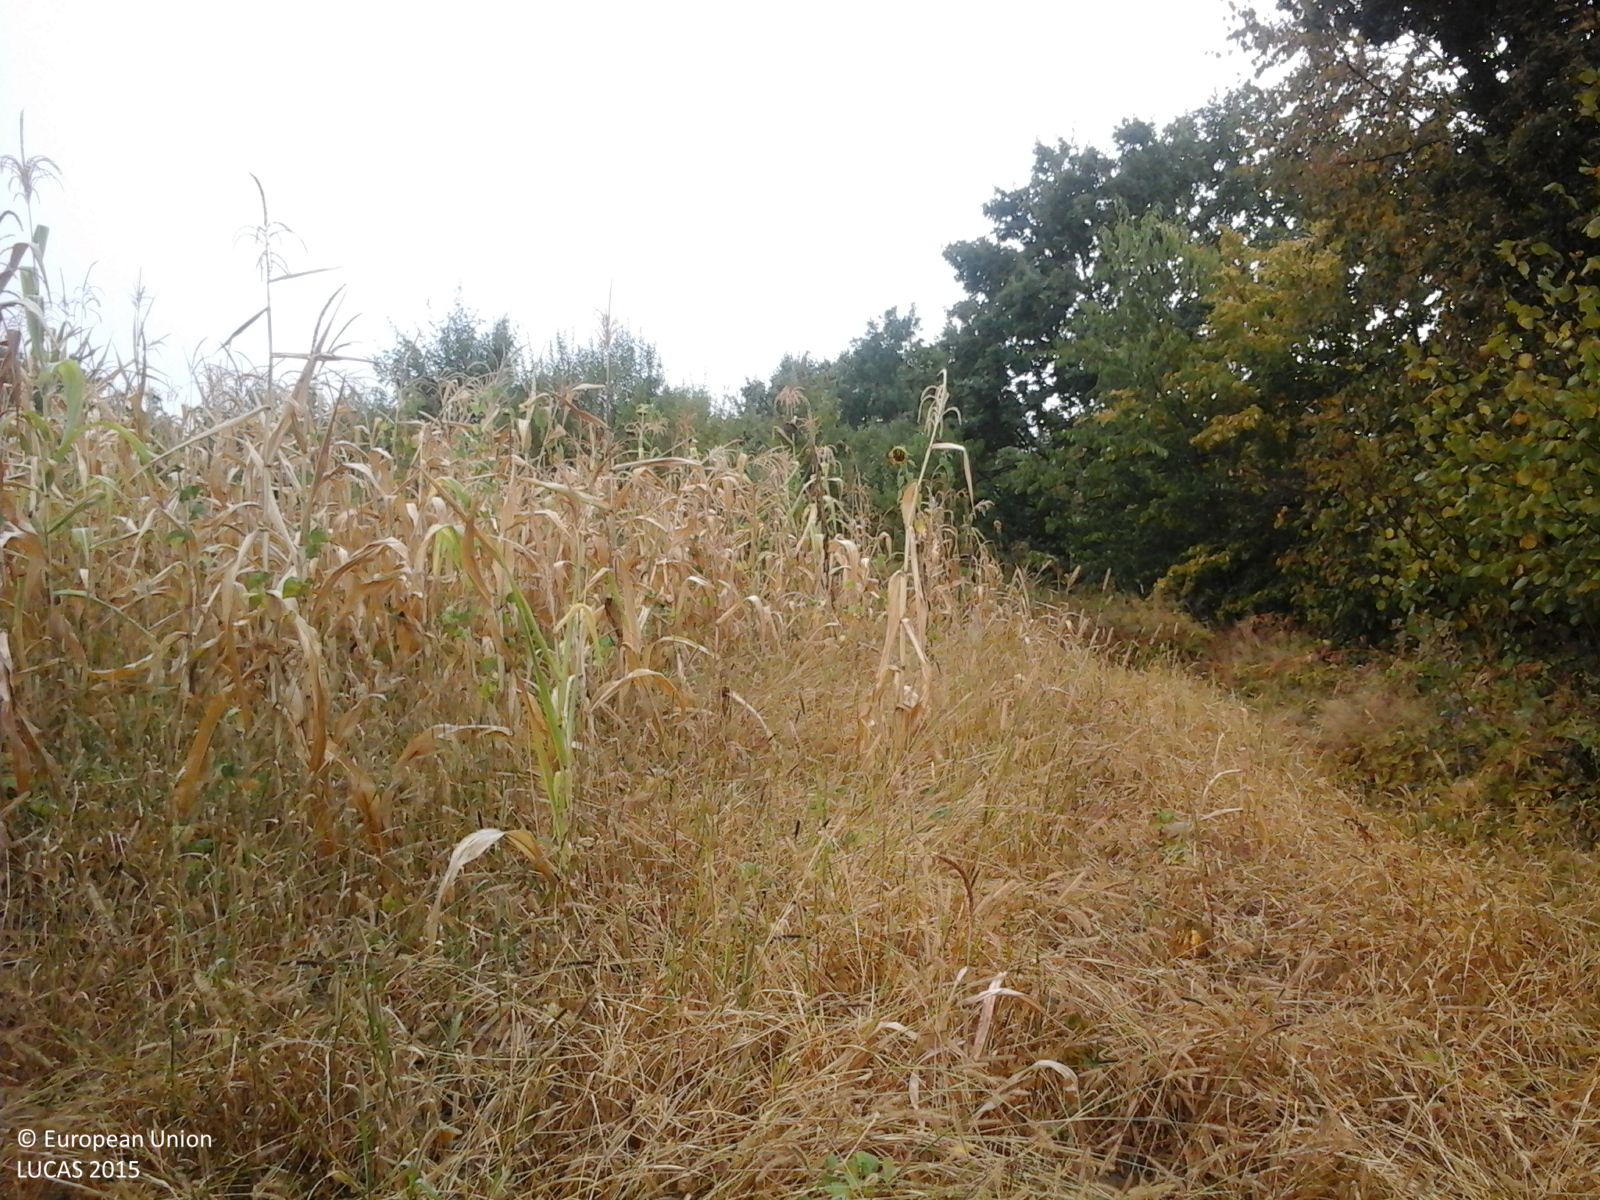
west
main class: Cropland
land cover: Maize
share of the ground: > 75 %
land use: Agriculture (excluding fallow land and kitchen gardens)
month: September
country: RO
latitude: 47.6189
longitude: 23.5536
